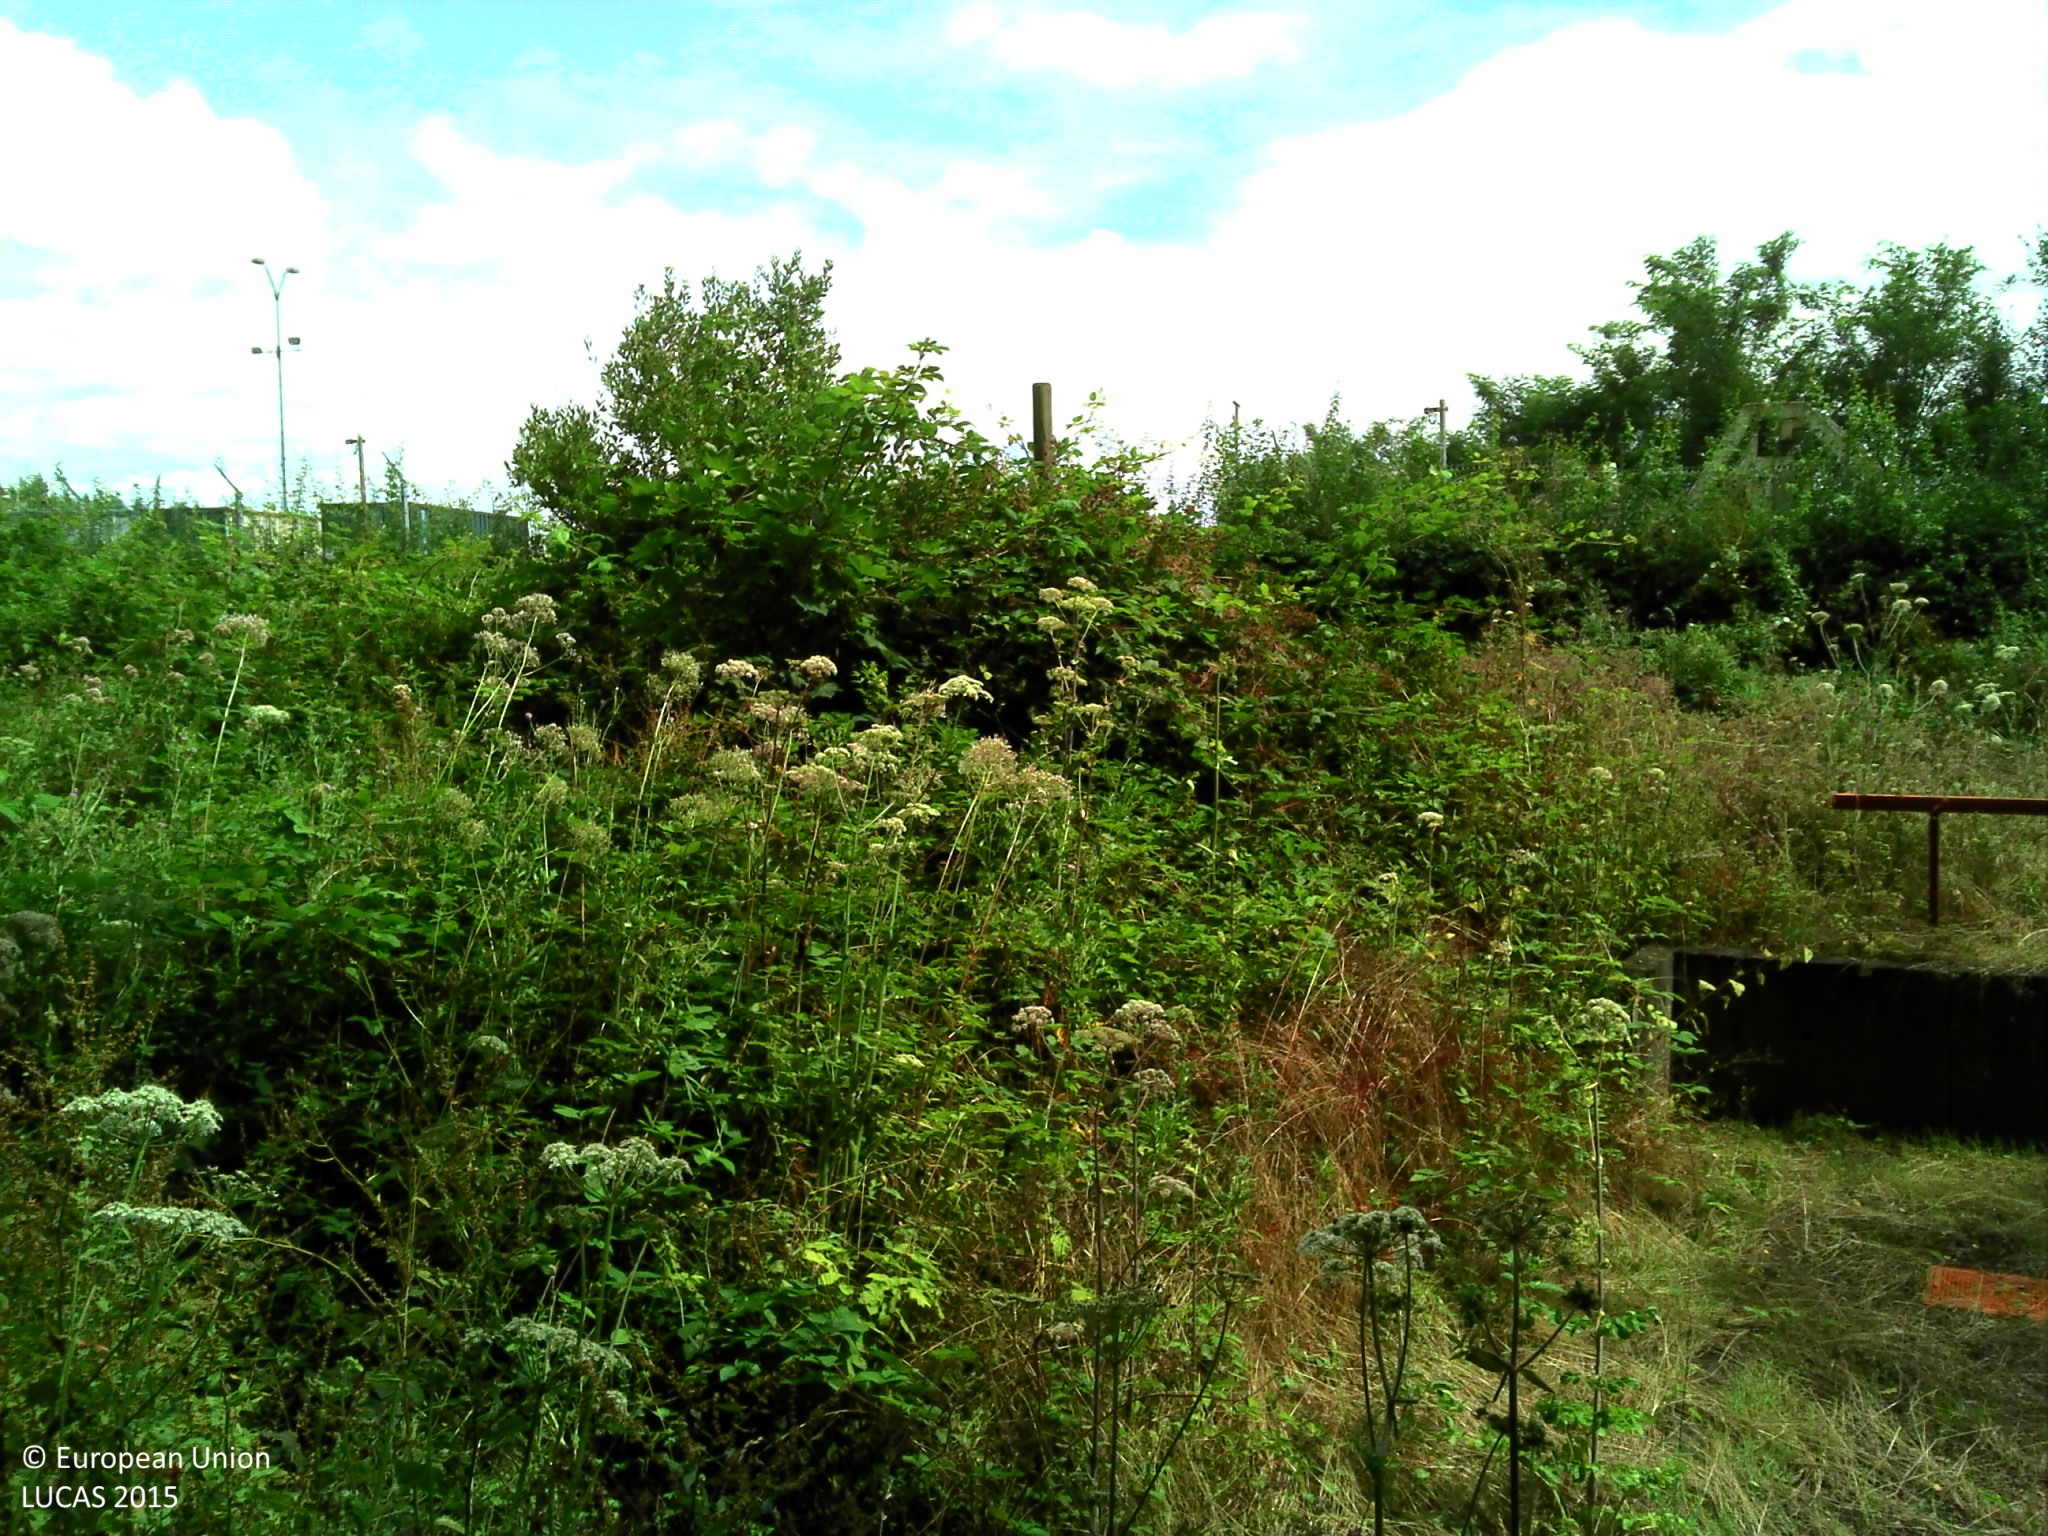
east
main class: Woodland
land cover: Spruce dominated mixed woodland
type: exotic forest
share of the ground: > 75 %
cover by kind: broadleaved forest trees 50 %, shrubs 25 %, coniferous forest trees 20 %, herbaceous plants 5 %
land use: Forestry
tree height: > 5 m
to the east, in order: Spruce dominated mixed woodland; Broadleaved woodland; Other structural elements; Shrubland without tree cover; Artificial constructions in urban areas
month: July
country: BE
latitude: 50.4489
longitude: 4.5176
